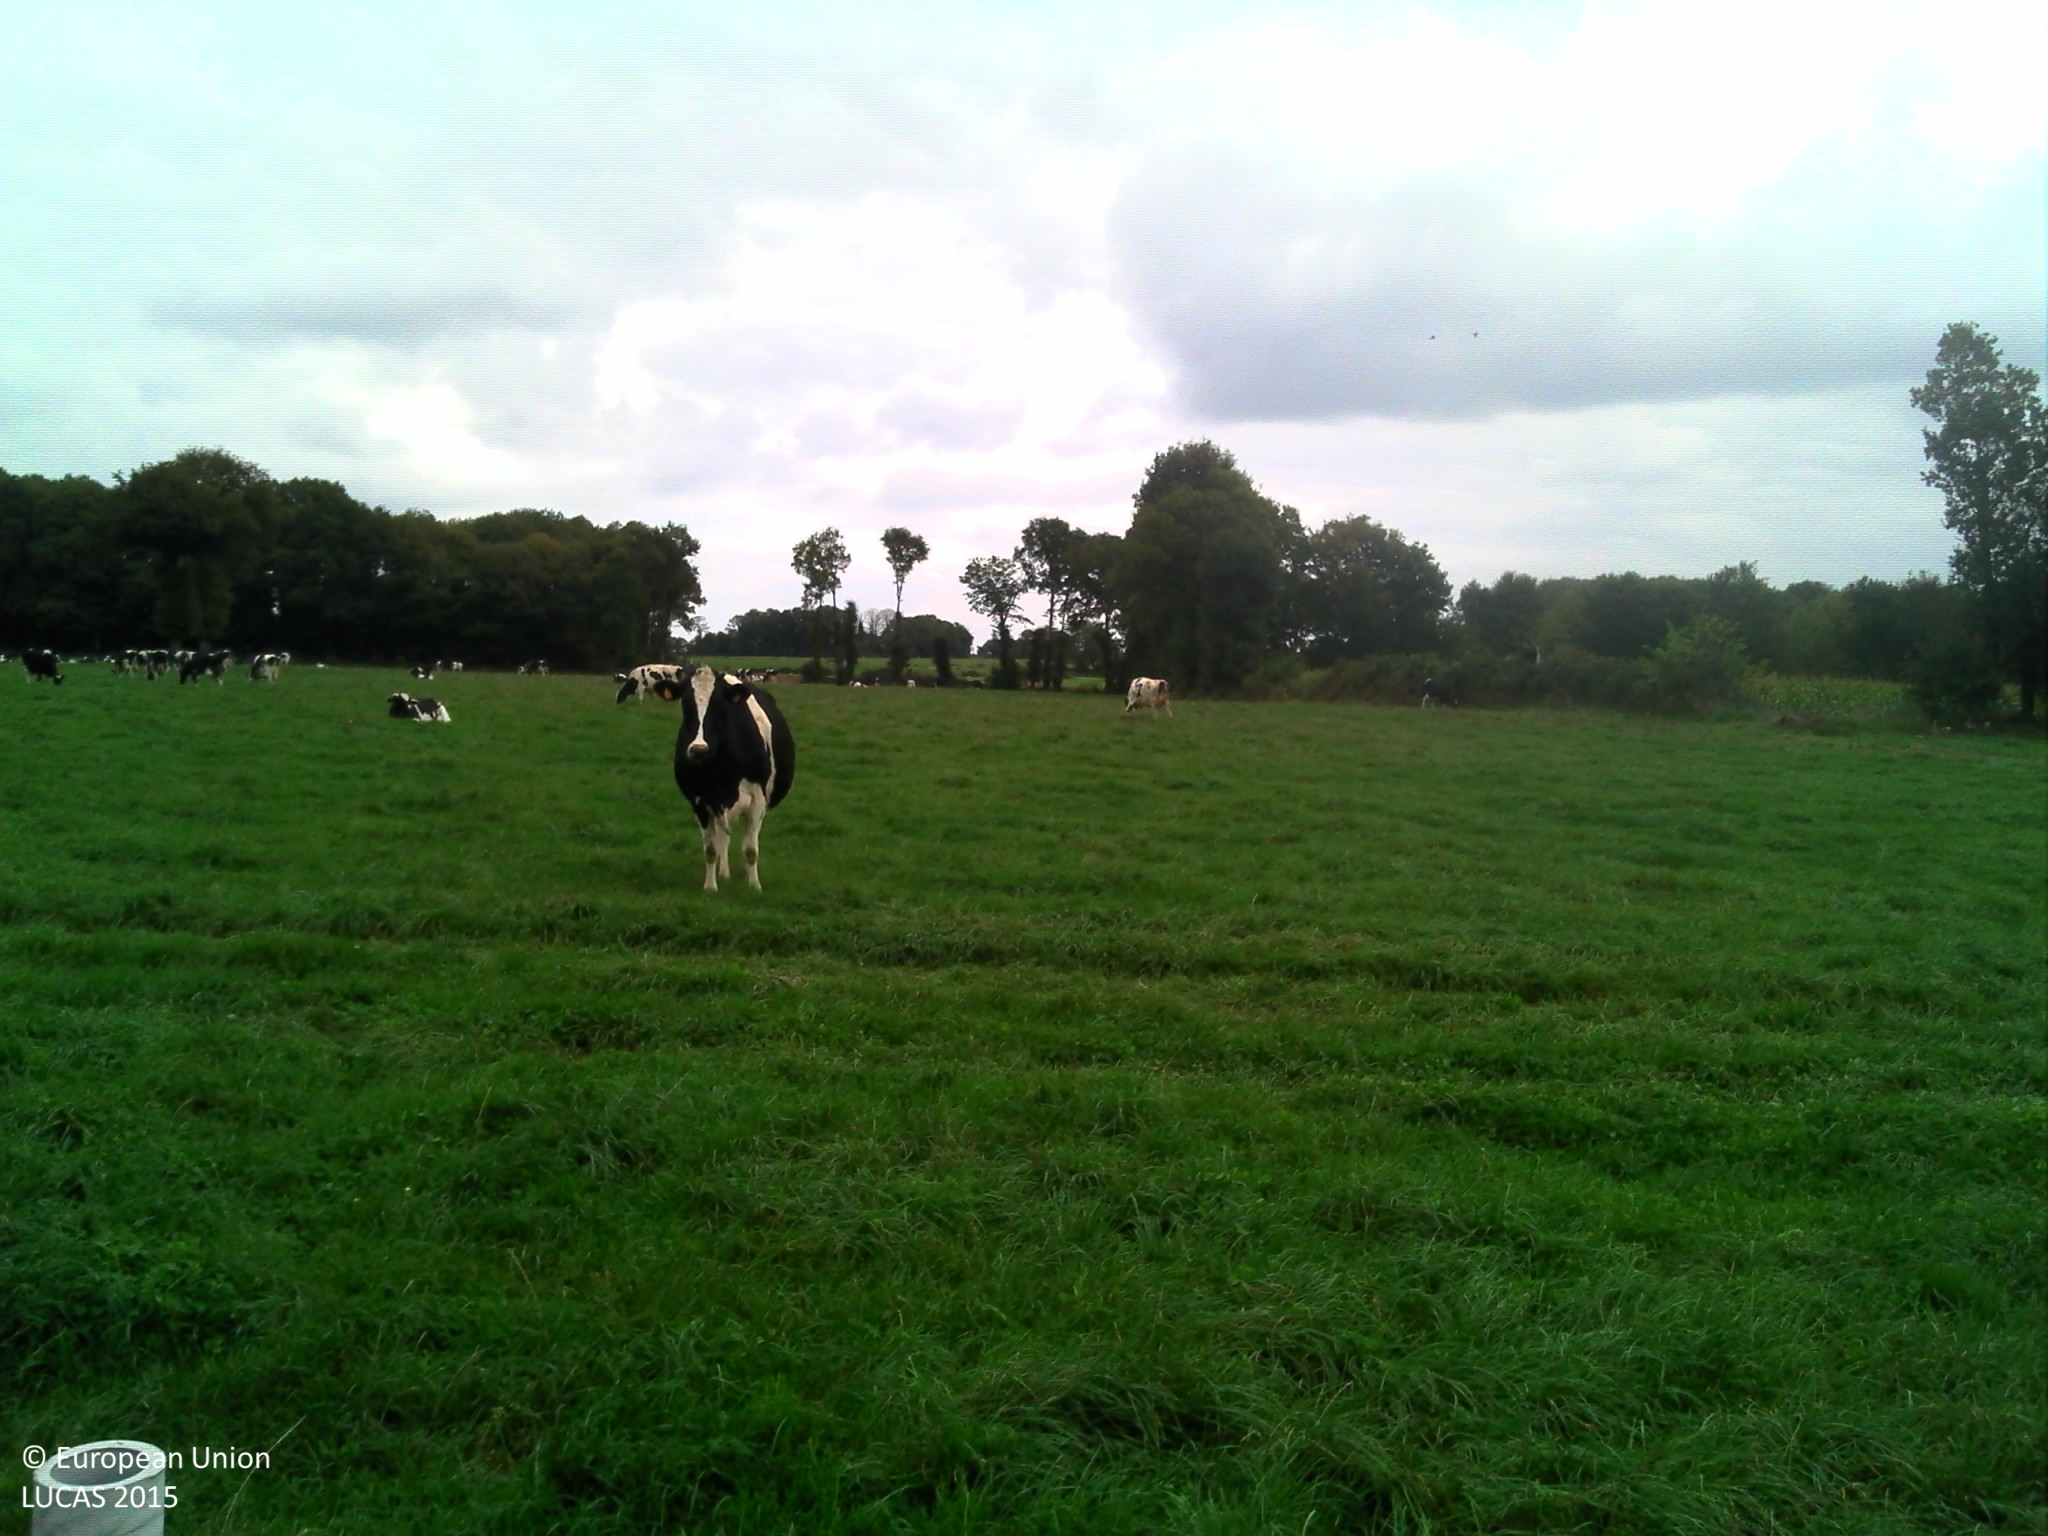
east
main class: Grassland
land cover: Grassland without tree/shrub cover
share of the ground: > 75 %
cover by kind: herbaceous plants 100 %
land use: Agriculture (excluding fallow land and kitchen gardens)
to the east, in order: Grassland without tree/shrub cover; Fences; Lines of trees; Other bare soil
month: October
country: FR
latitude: 48.1028
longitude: -2.3999
